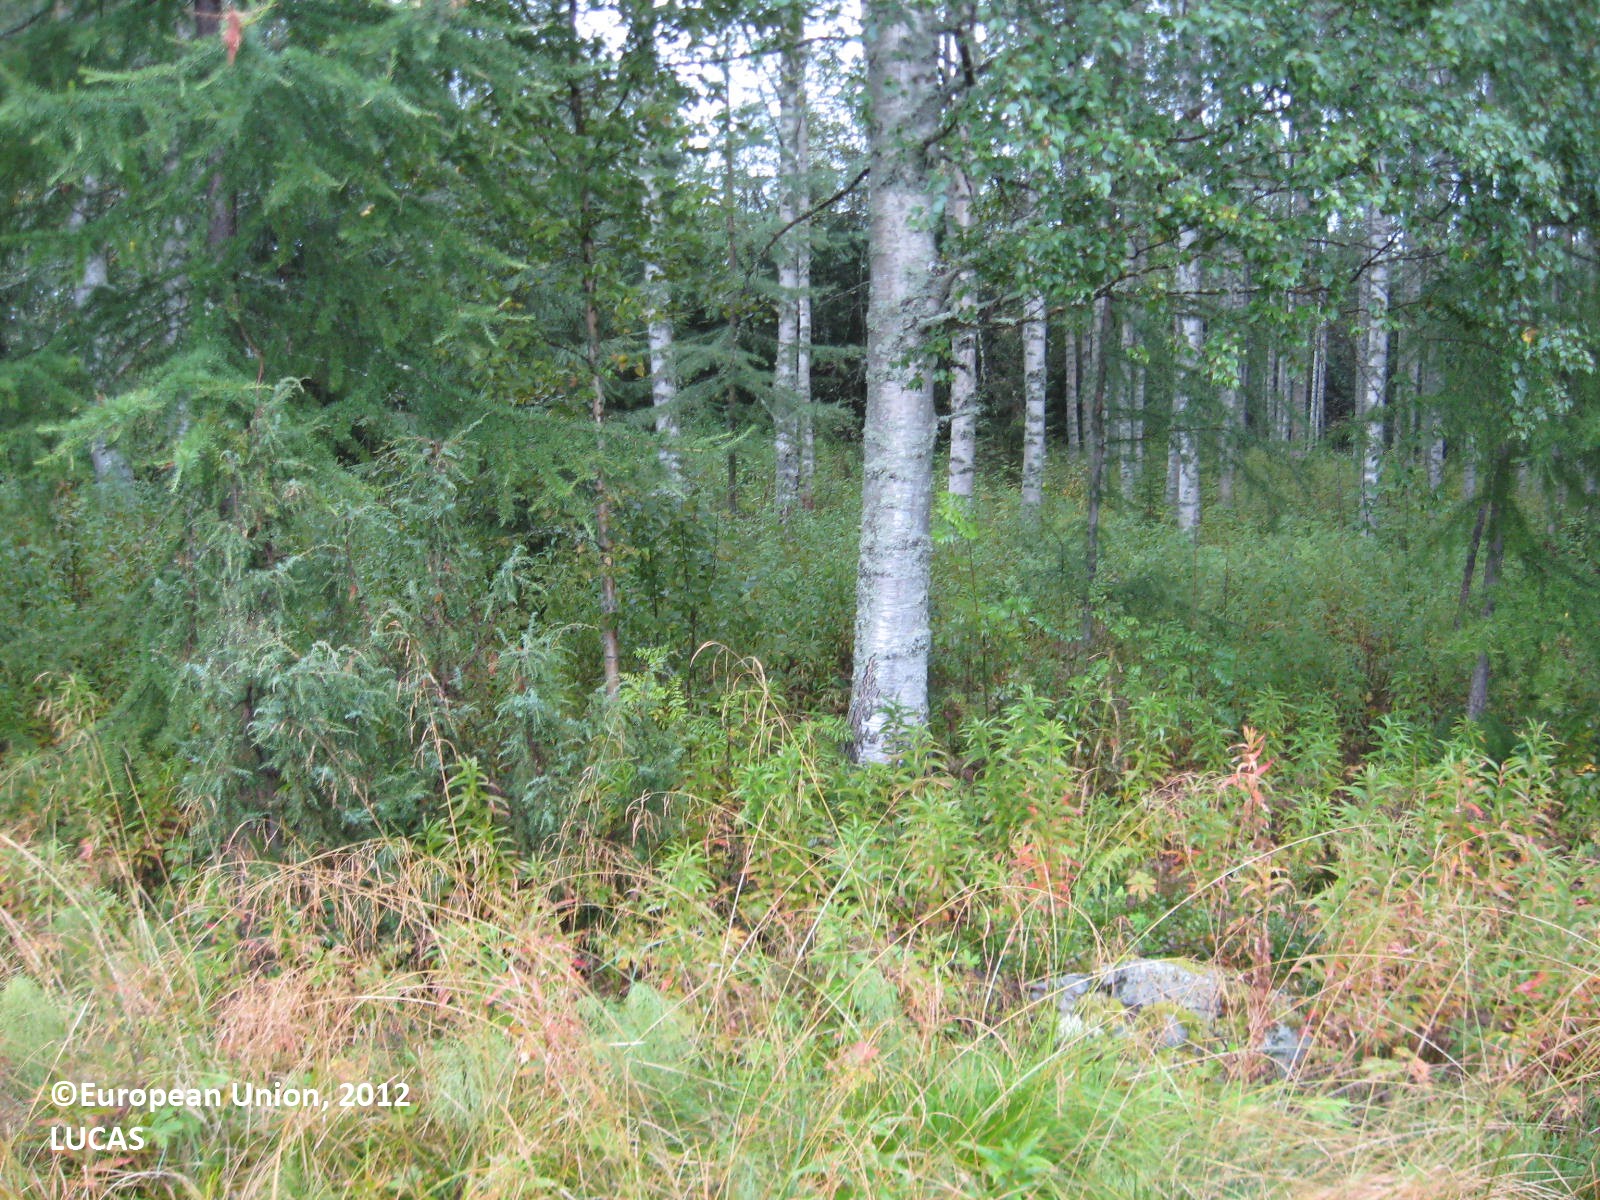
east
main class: Grassland
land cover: Spontaneously vegetated surfaces
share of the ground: > 75 %
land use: Residential
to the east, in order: Spontaneously vegetated surfaces; Spruce dominated mixed woodland; Other mixed woodland; Tracks; Other mixed woodland; Broadleaved woodland; Lines of trees; Broadleaved woodland; Other mixed woodland
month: August
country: FI
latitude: 63.5716
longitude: 29.7084
